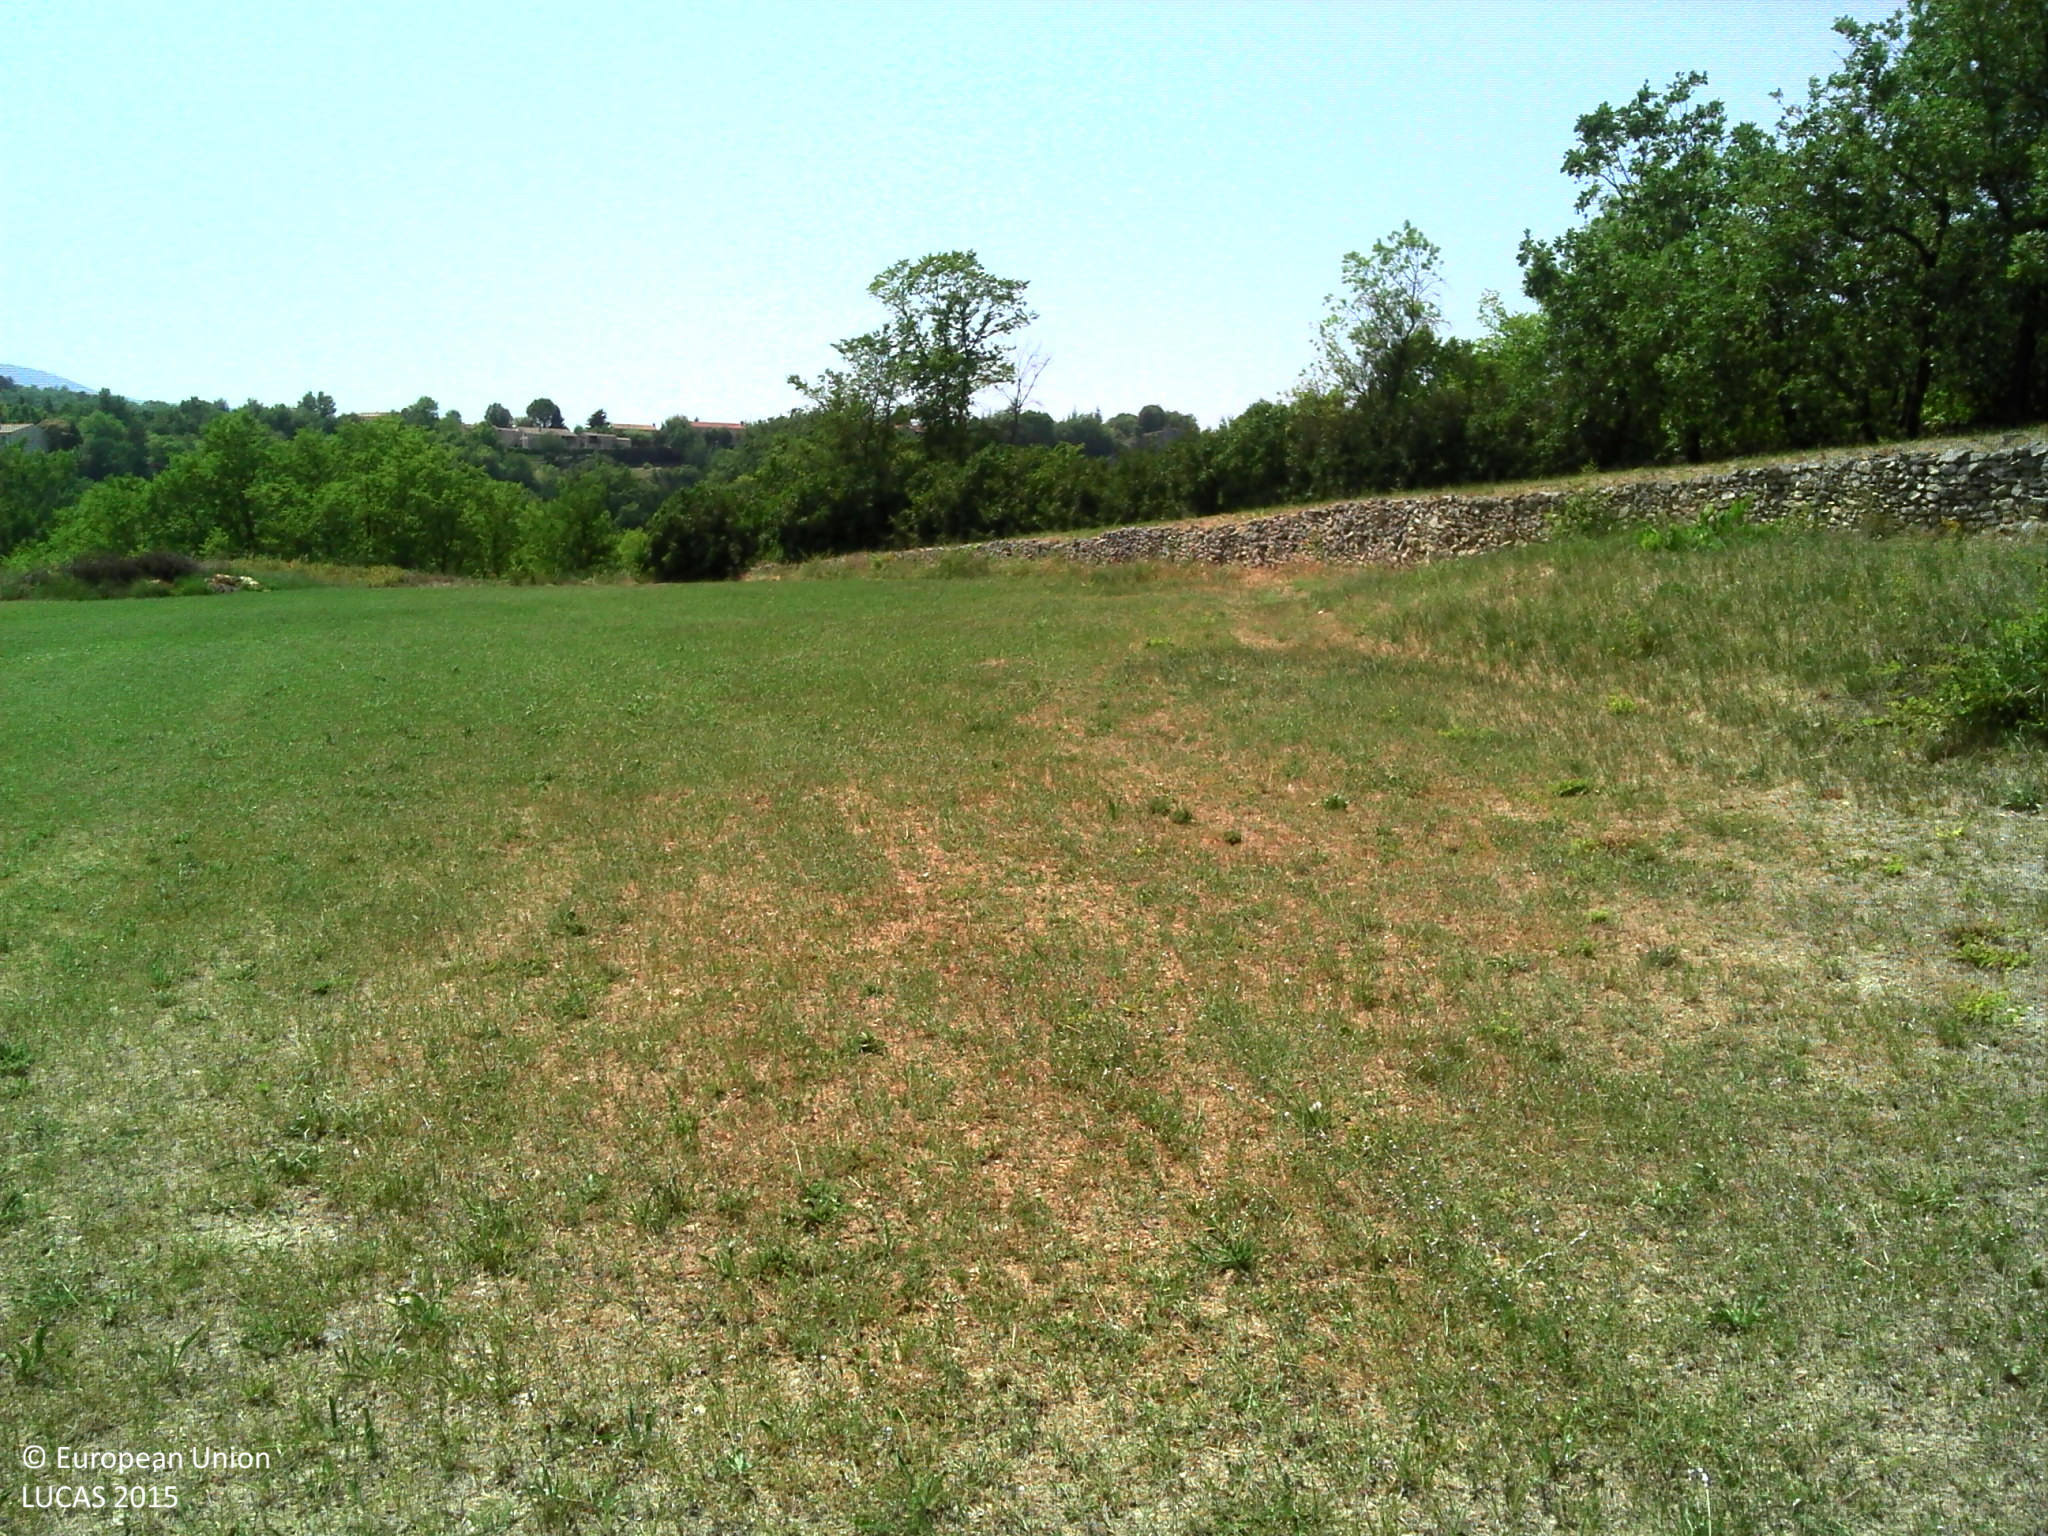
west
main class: Grassland
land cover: Grassland without tree/shrub cover
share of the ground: 50 - 75 %
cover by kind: herbaceous plants 85 %, consolidated bare surface 10 %, shrubs 5 %
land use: Residential
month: July
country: FR
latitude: 43.8595
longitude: 5.5919
